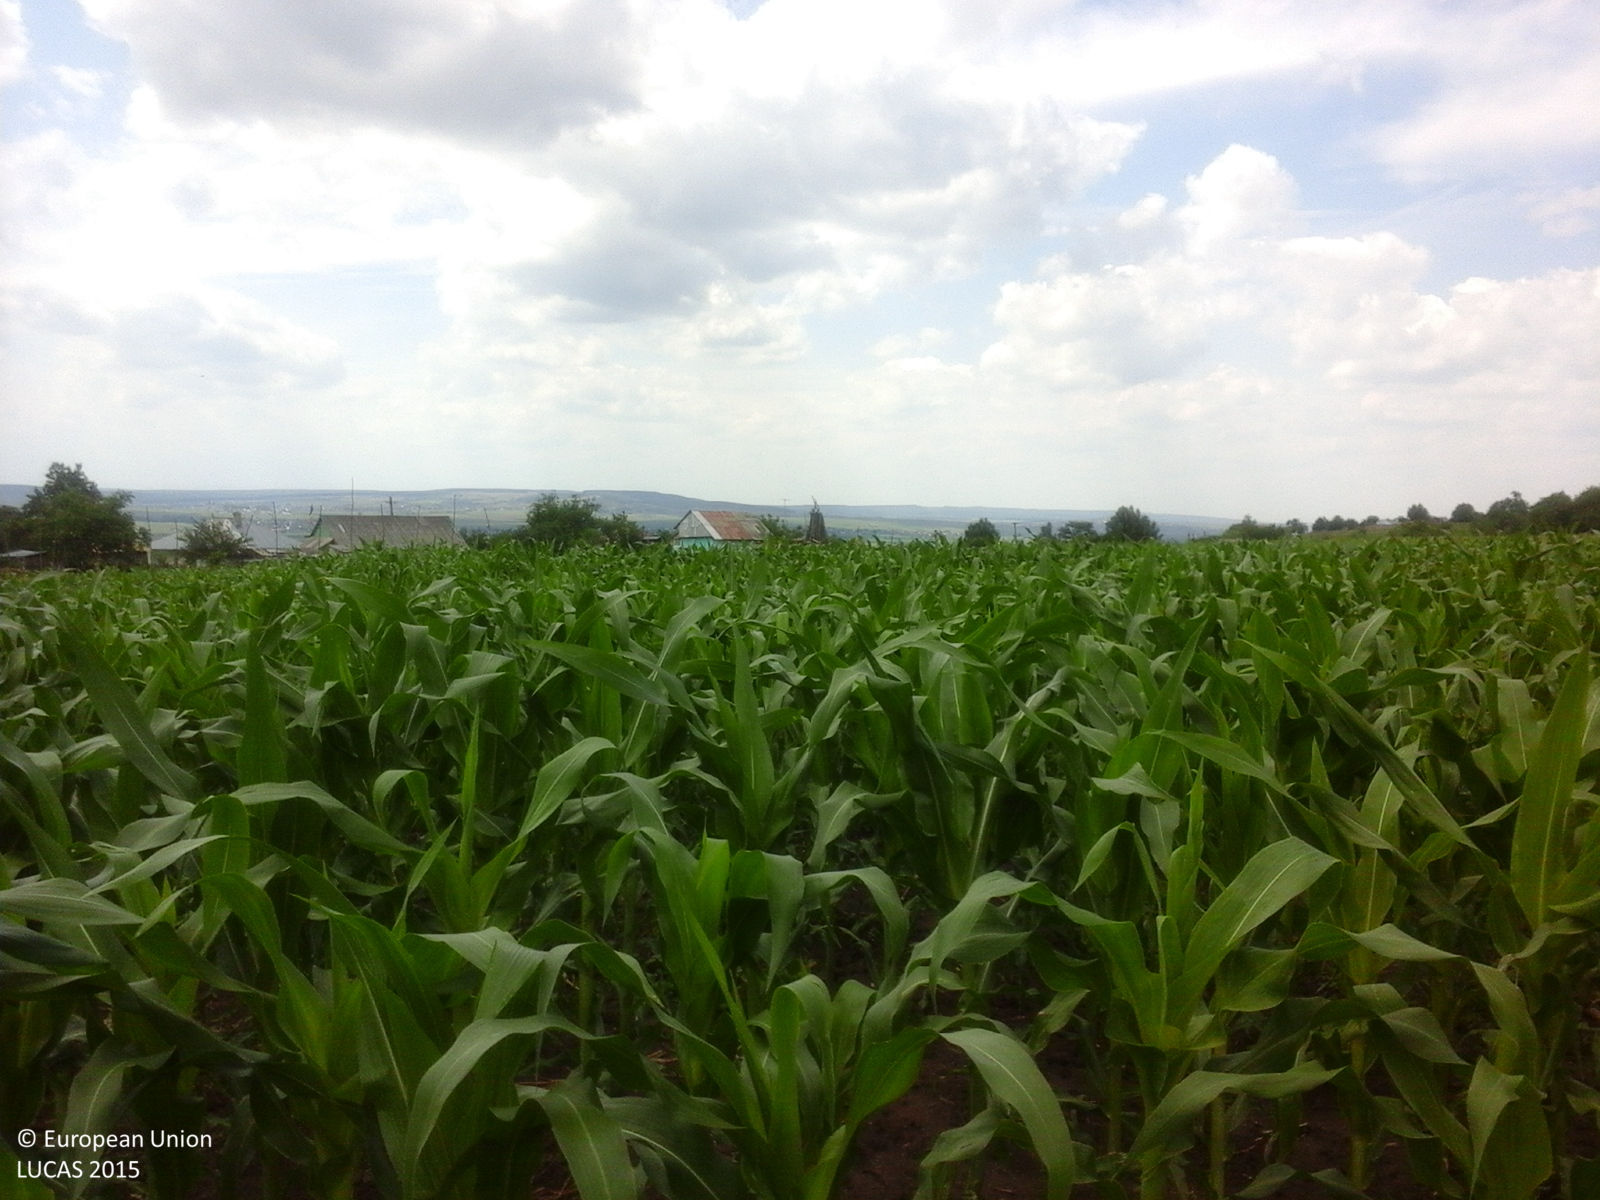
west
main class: Cropland
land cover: Maize
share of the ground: 50 - 75 %
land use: Agriculture (excluding fallow land and kitchen gardens)
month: June
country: RO
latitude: 47.8114
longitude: 26.3934
